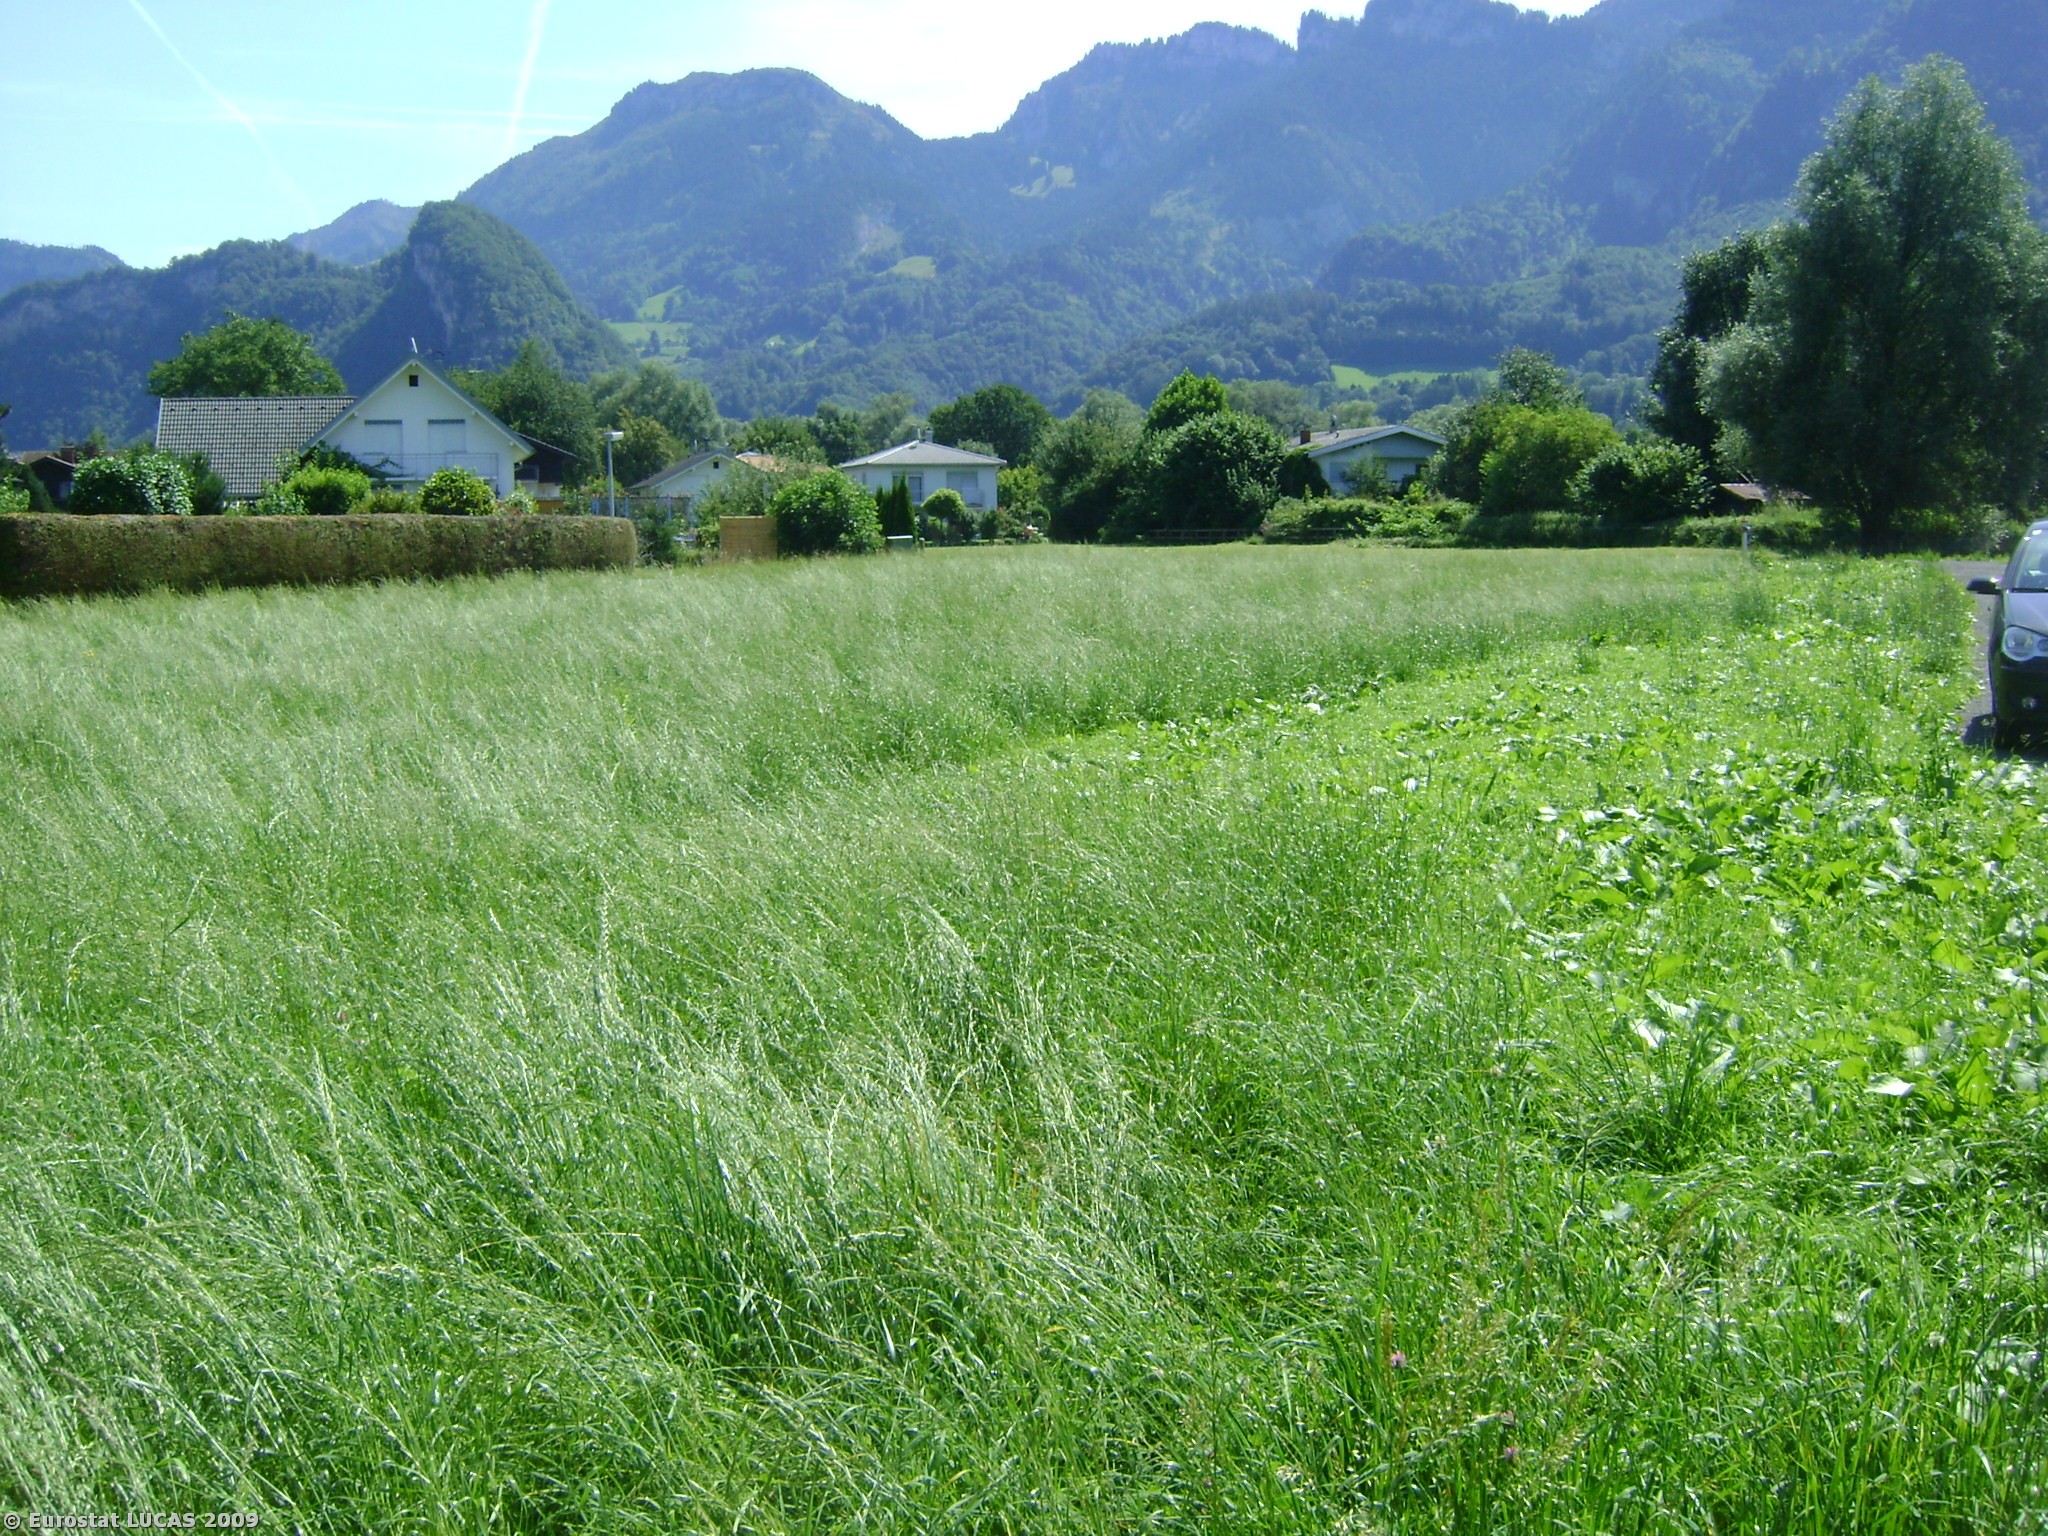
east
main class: Grassland
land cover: Grassland without tree/shrub cover
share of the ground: > 75 %
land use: Agriculture (excluding fallow land and kitchen gardens)
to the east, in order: Grassland without tree/shrub cover; Artificial constructions in urban areas; Paved roads, cycling and walking lanes; Grassland without tree/shrub cover; Rivers and streams; Grassland without tree/shrub cover; Artificial constructions in urban areas; Tracks; Shrubland without tree cover; Artificial constructions; Railways
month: July
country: AT
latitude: 47.3591
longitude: 9.6693
